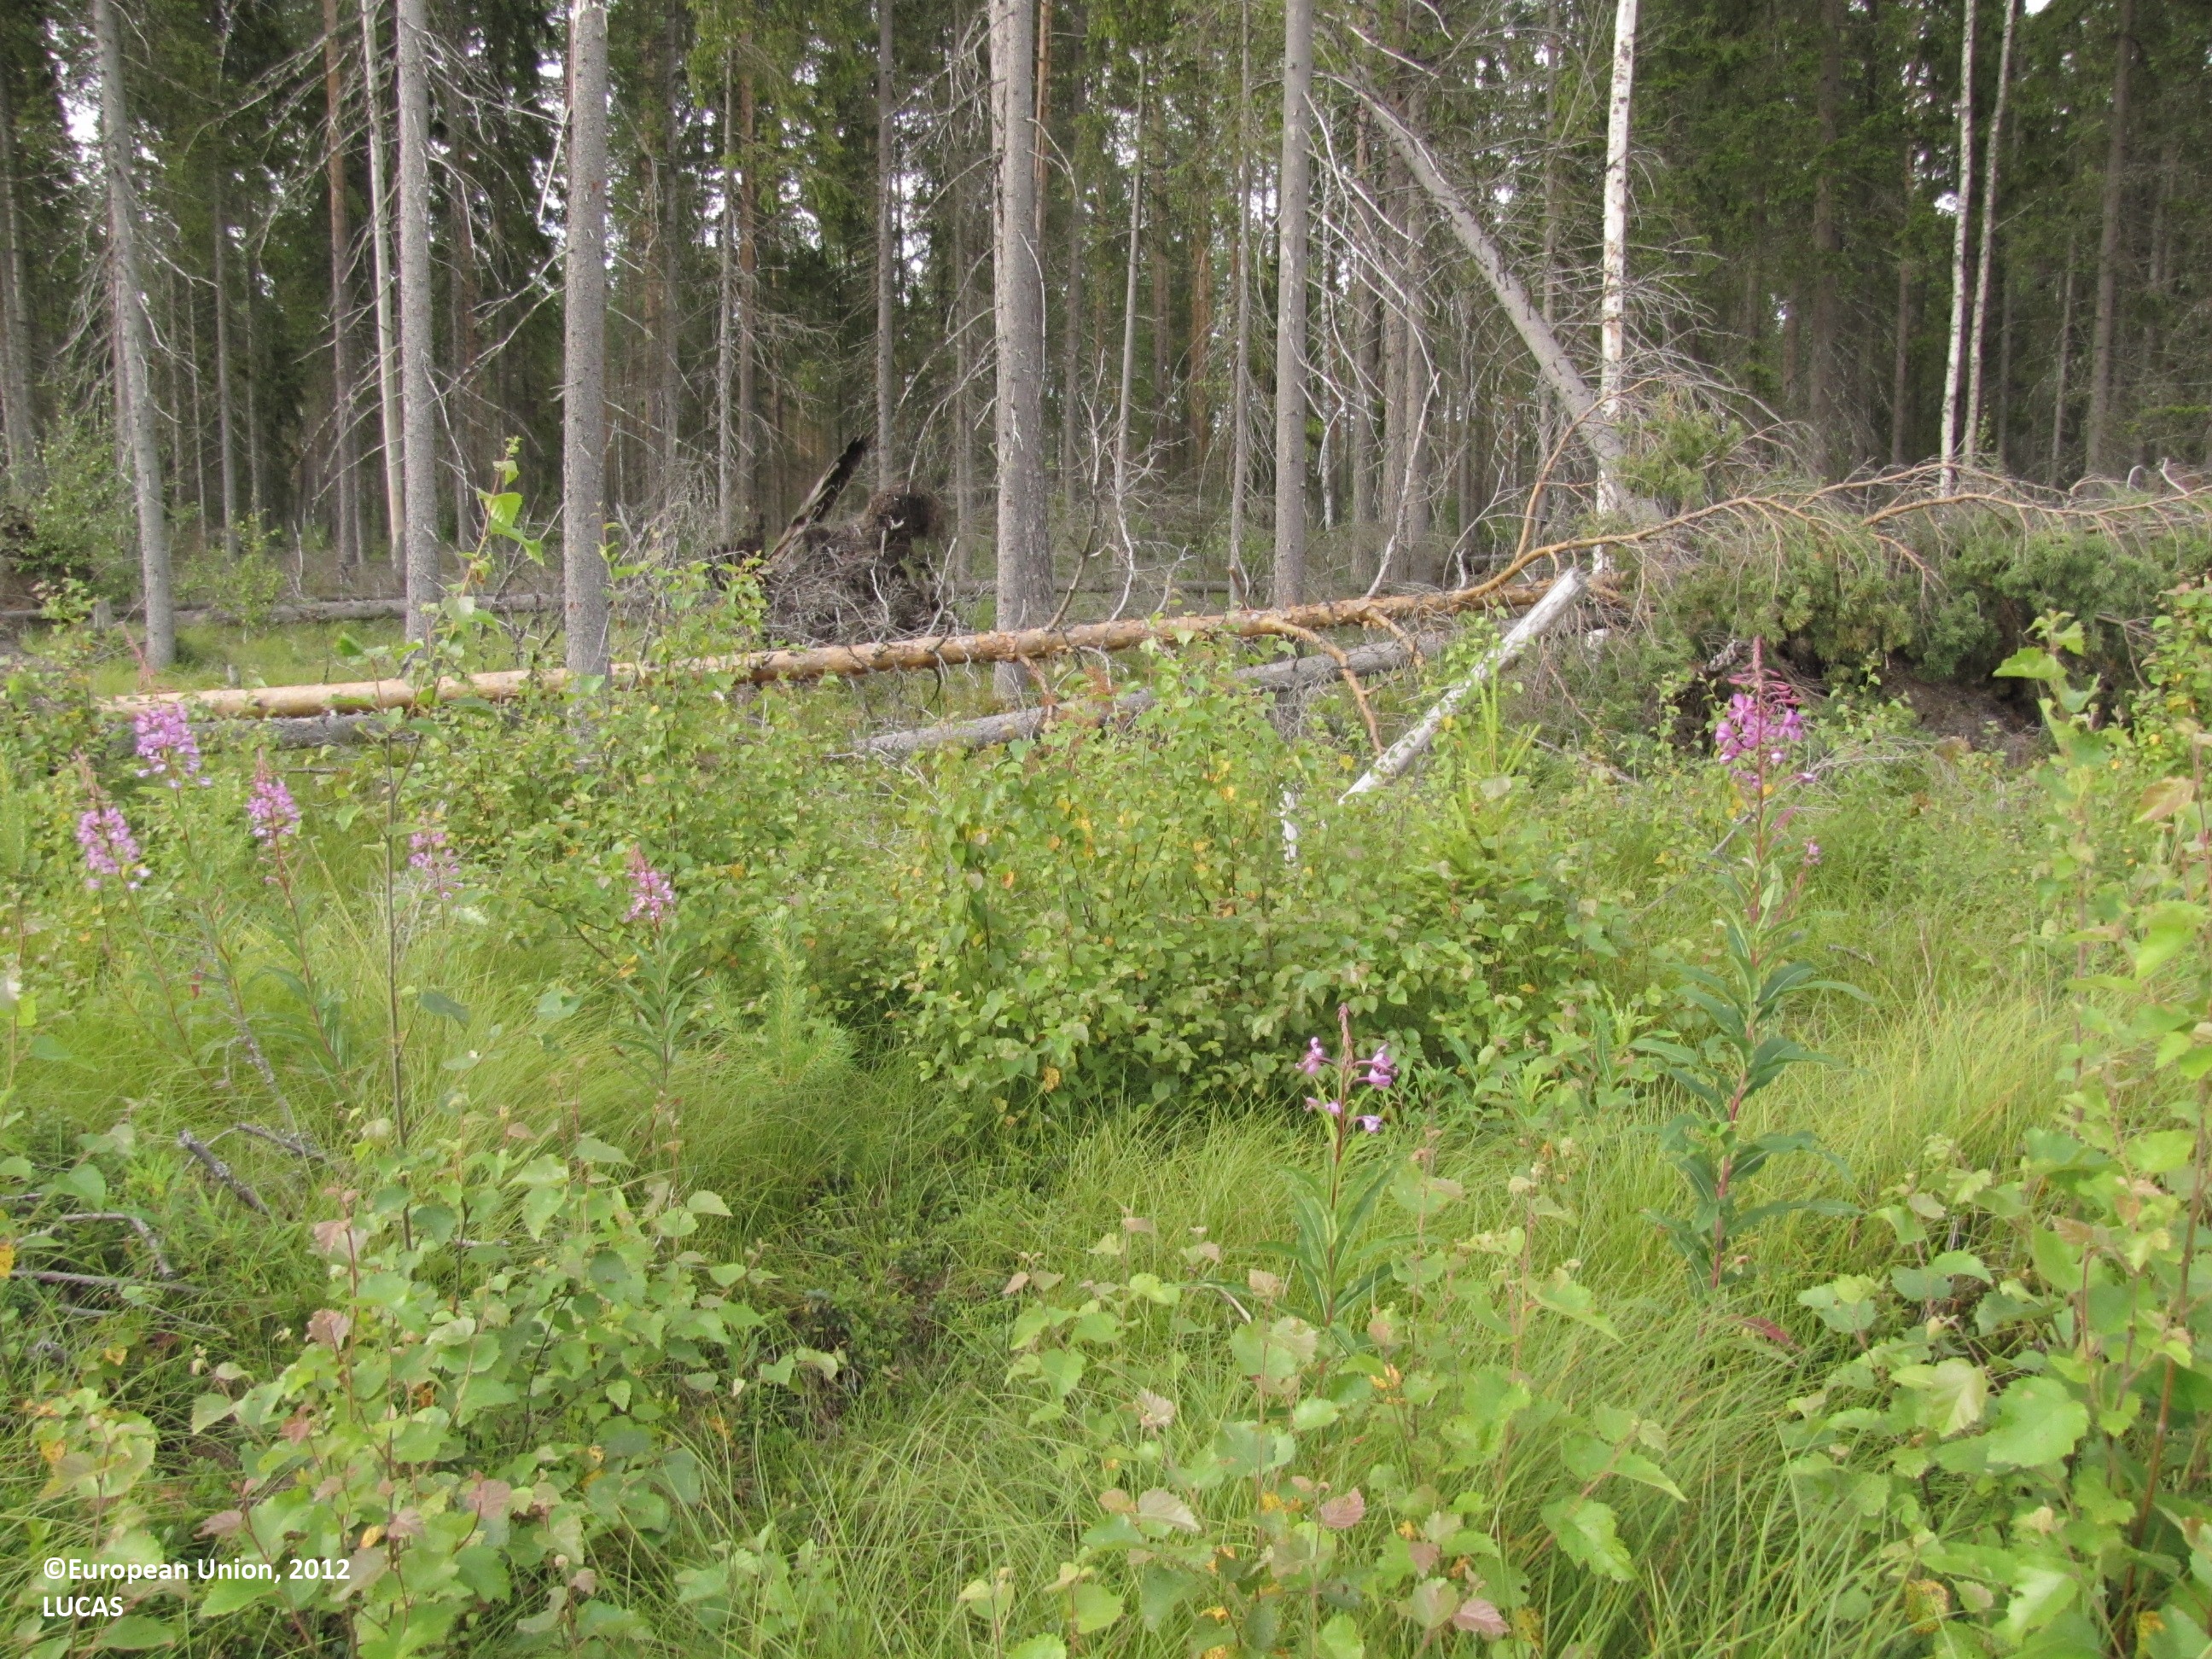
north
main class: Woodland
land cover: Spruce dominated mixed woodland
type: boreal forest
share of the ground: 50 - 75 %
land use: Forestry
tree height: < 5 m
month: July
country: FI
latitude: 62.2885
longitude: 23.1558
